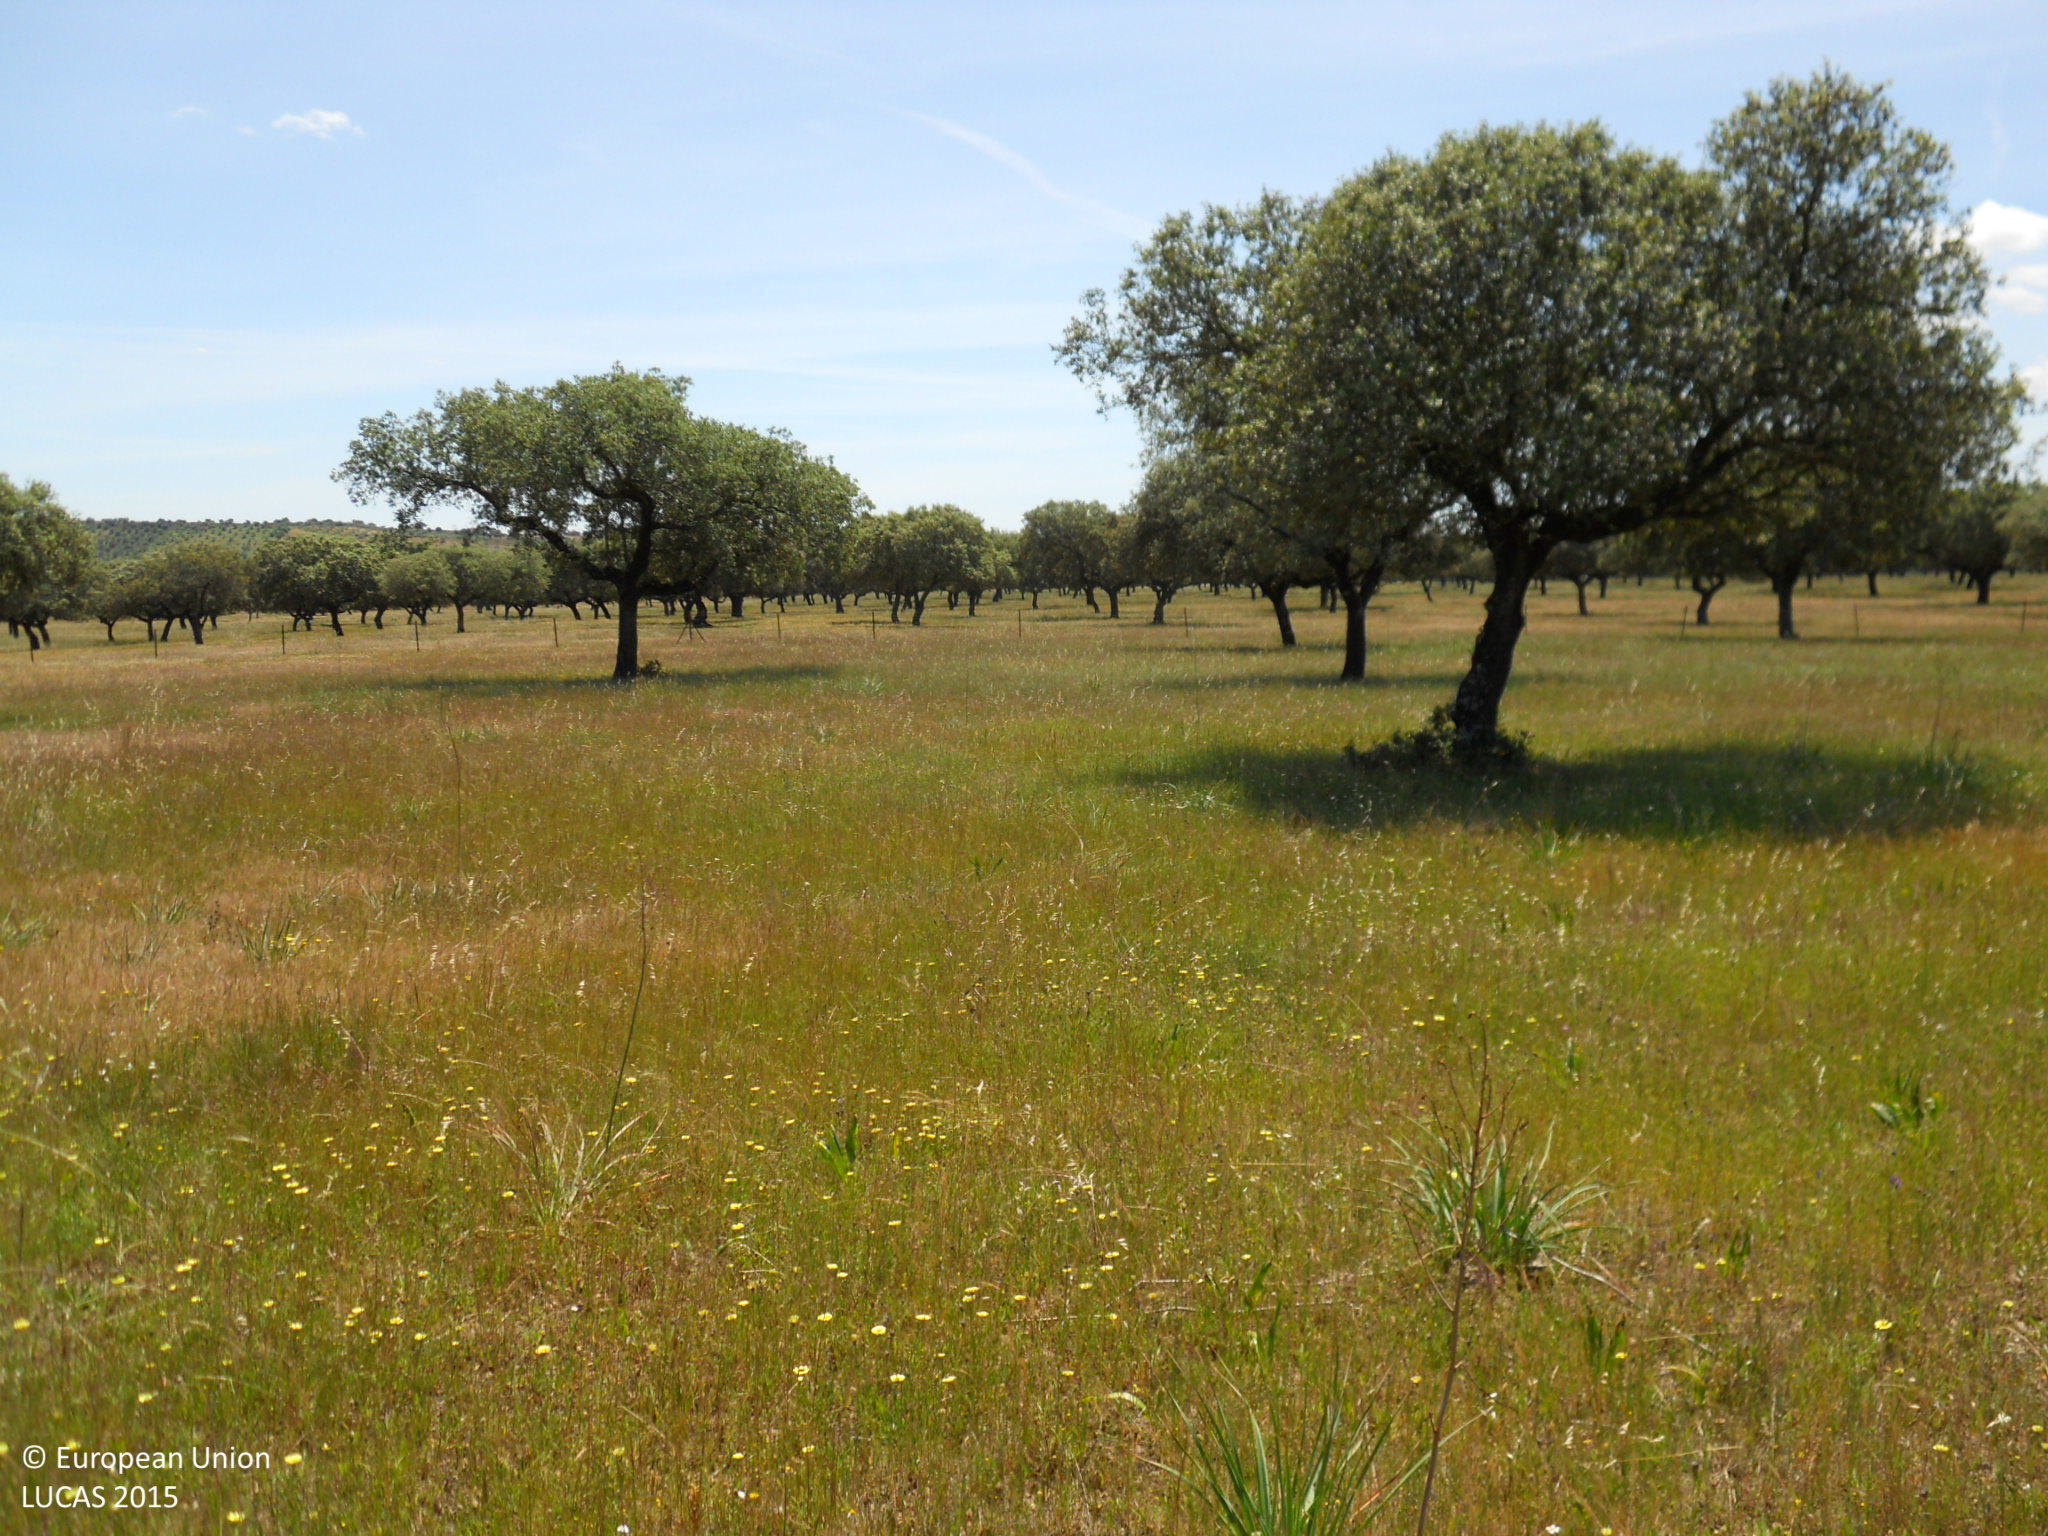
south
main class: Woodland
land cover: Broadleaved woodland
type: broadleaved evergreen forest
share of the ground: > 75 %
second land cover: Grassland without tree/shrub cover
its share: 50 - 75 %
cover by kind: broadleaved forest trees 90 %, herbaceous plants 10 %
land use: Forestry
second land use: Agriculture (excluding fallow land and kitchen gardens)
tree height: > 5 m
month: April
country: ES
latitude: 39.0958
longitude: -6.7299
